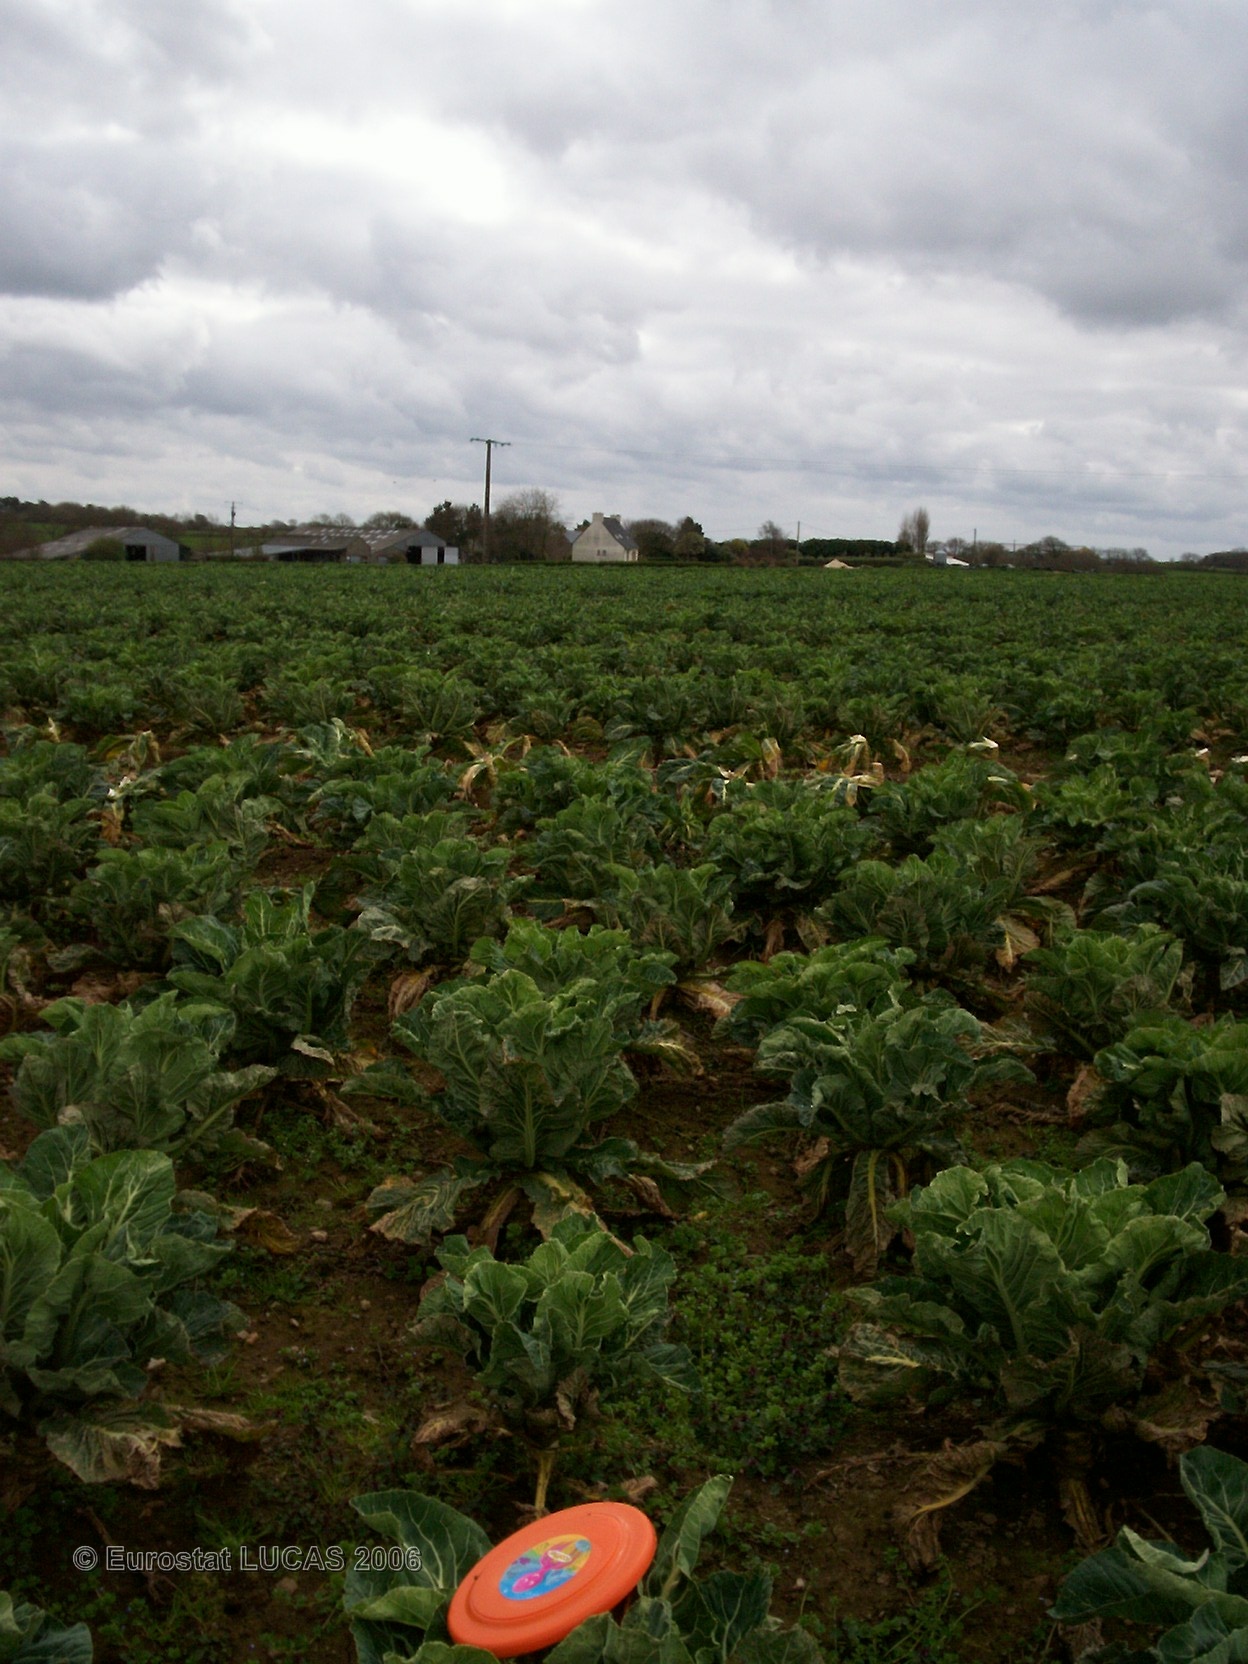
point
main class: Cropland
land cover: Other fresh vegetables
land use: Agriculture (excluding fallow land and kitchen gardens)
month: April
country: FR
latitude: 48.5445
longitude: -4.0278
